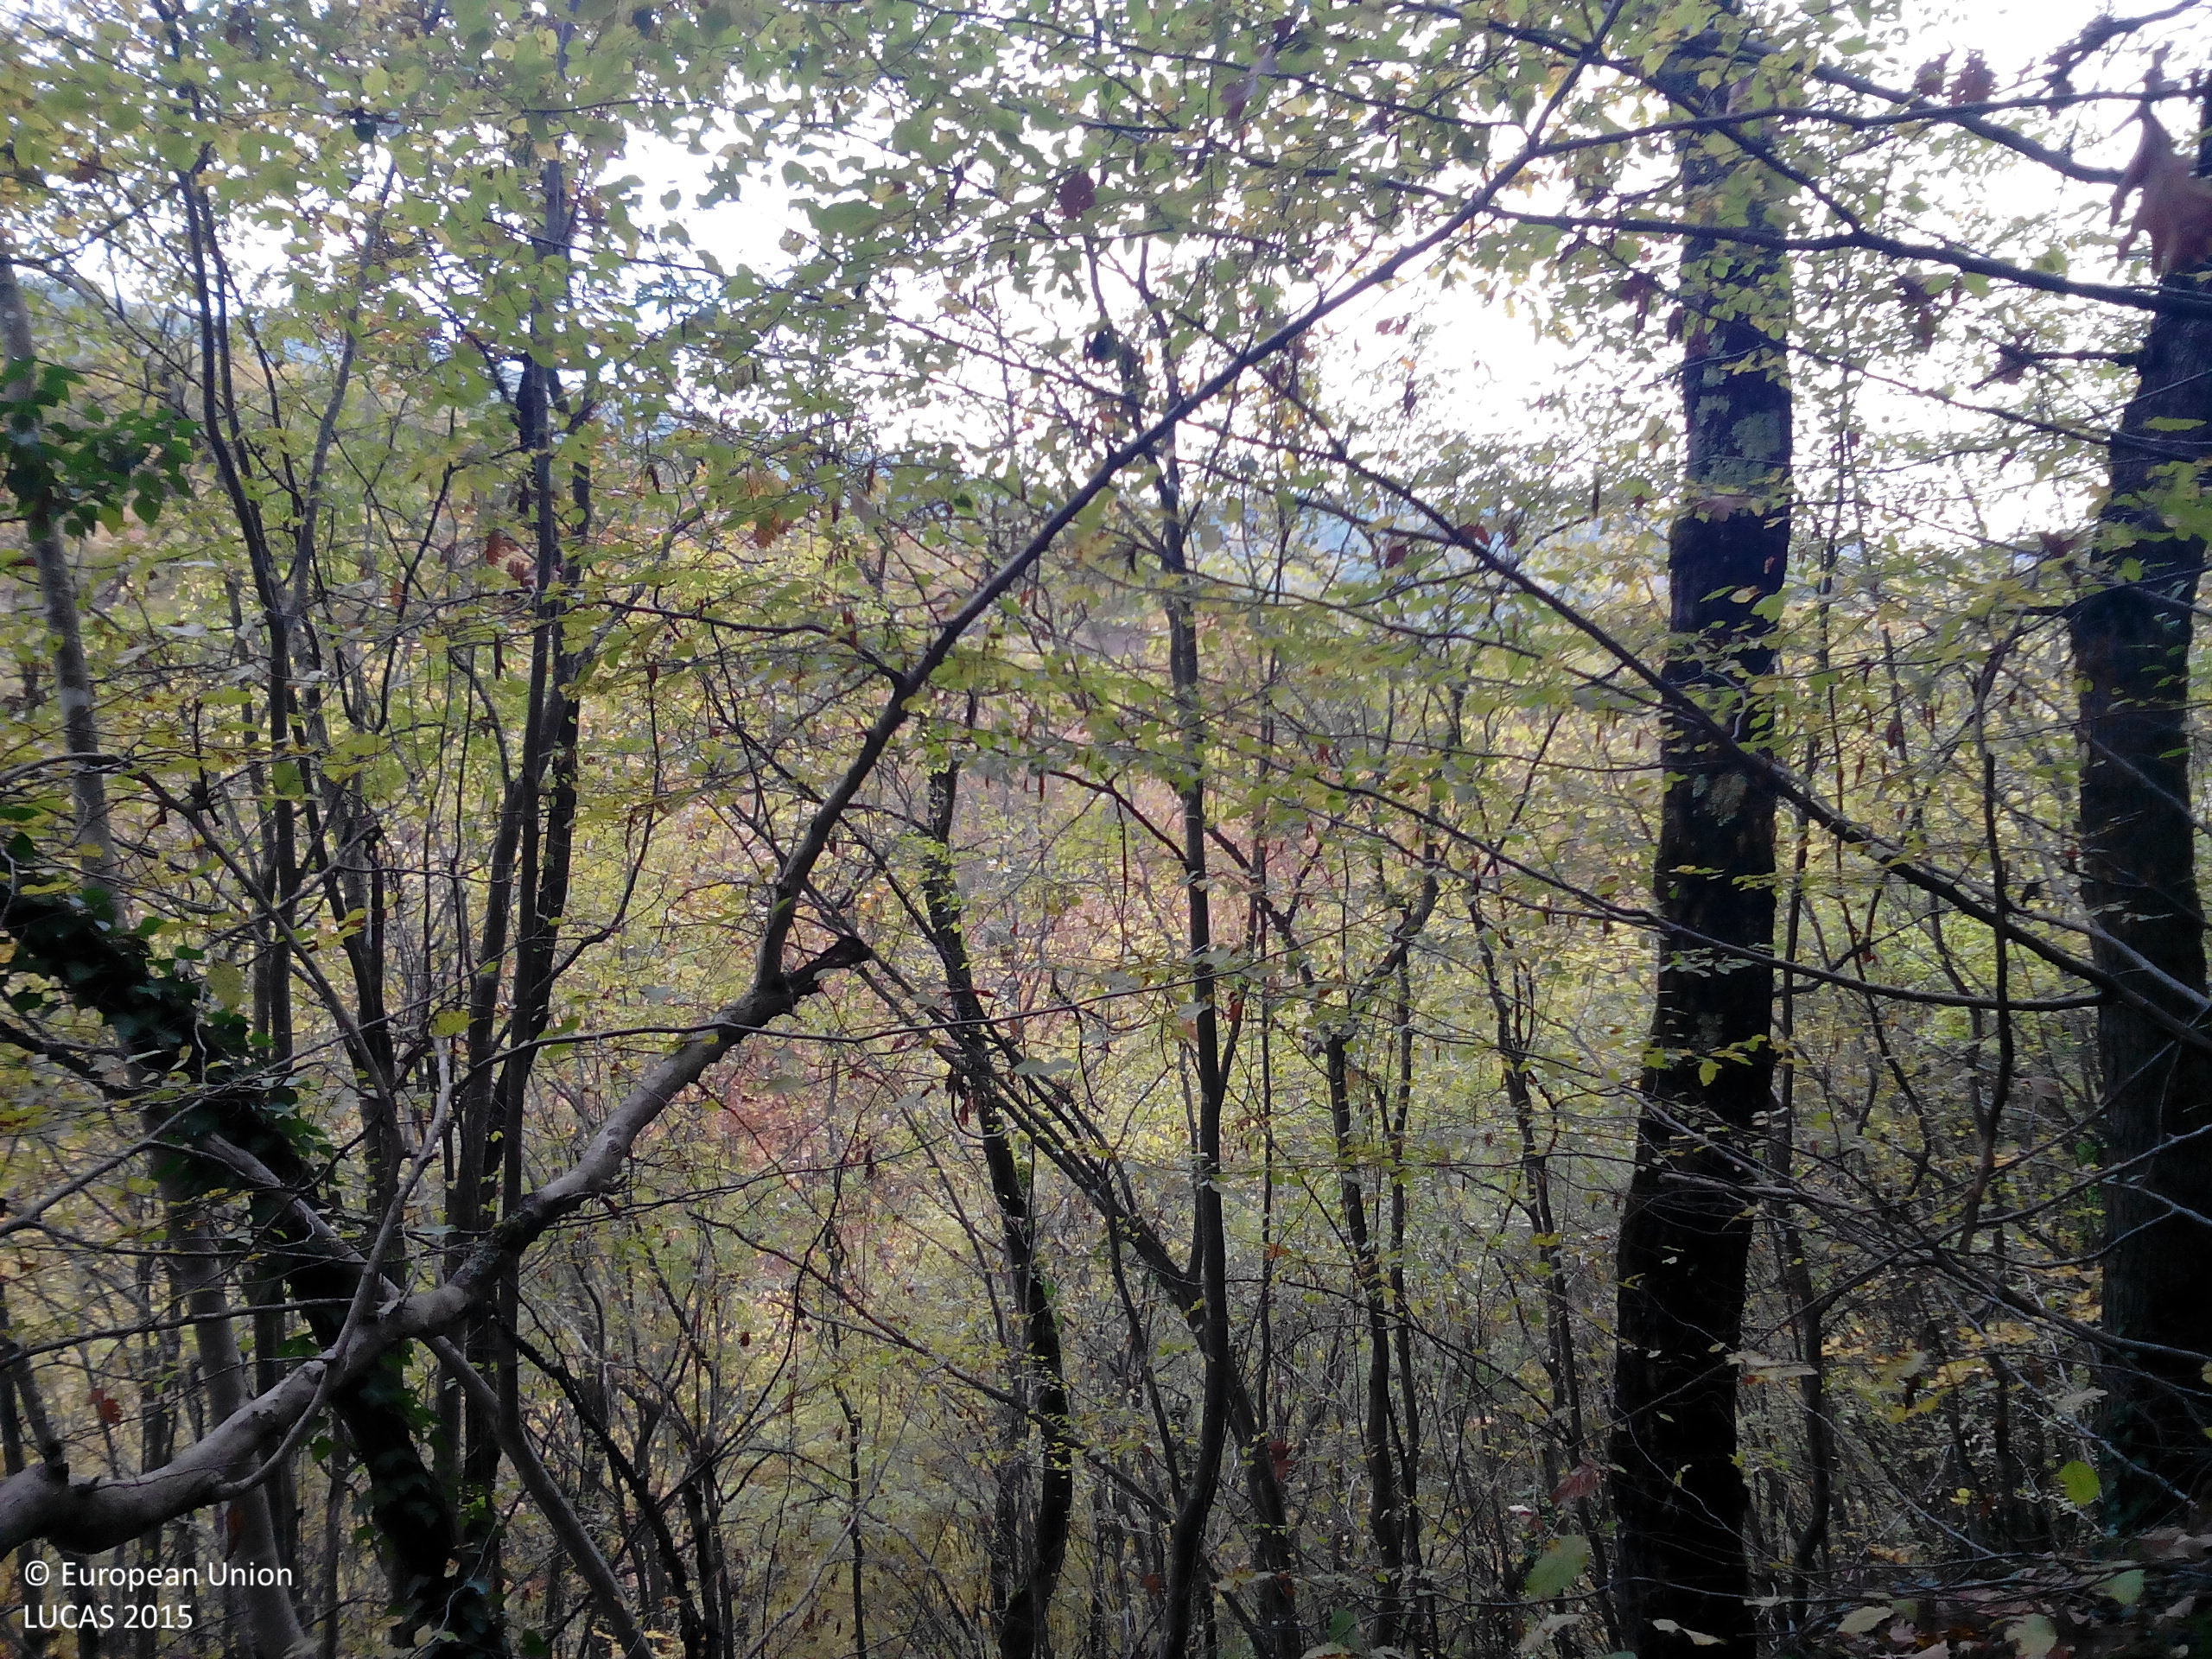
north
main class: Woodland
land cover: Broadleaved woodland
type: mesophytic deciduous forest
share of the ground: > 75 %
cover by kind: broadleaved forest trees 100 %
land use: Forestry
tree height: > 5 m
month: October
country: BG
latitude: 43.0322
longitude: 23.8530
